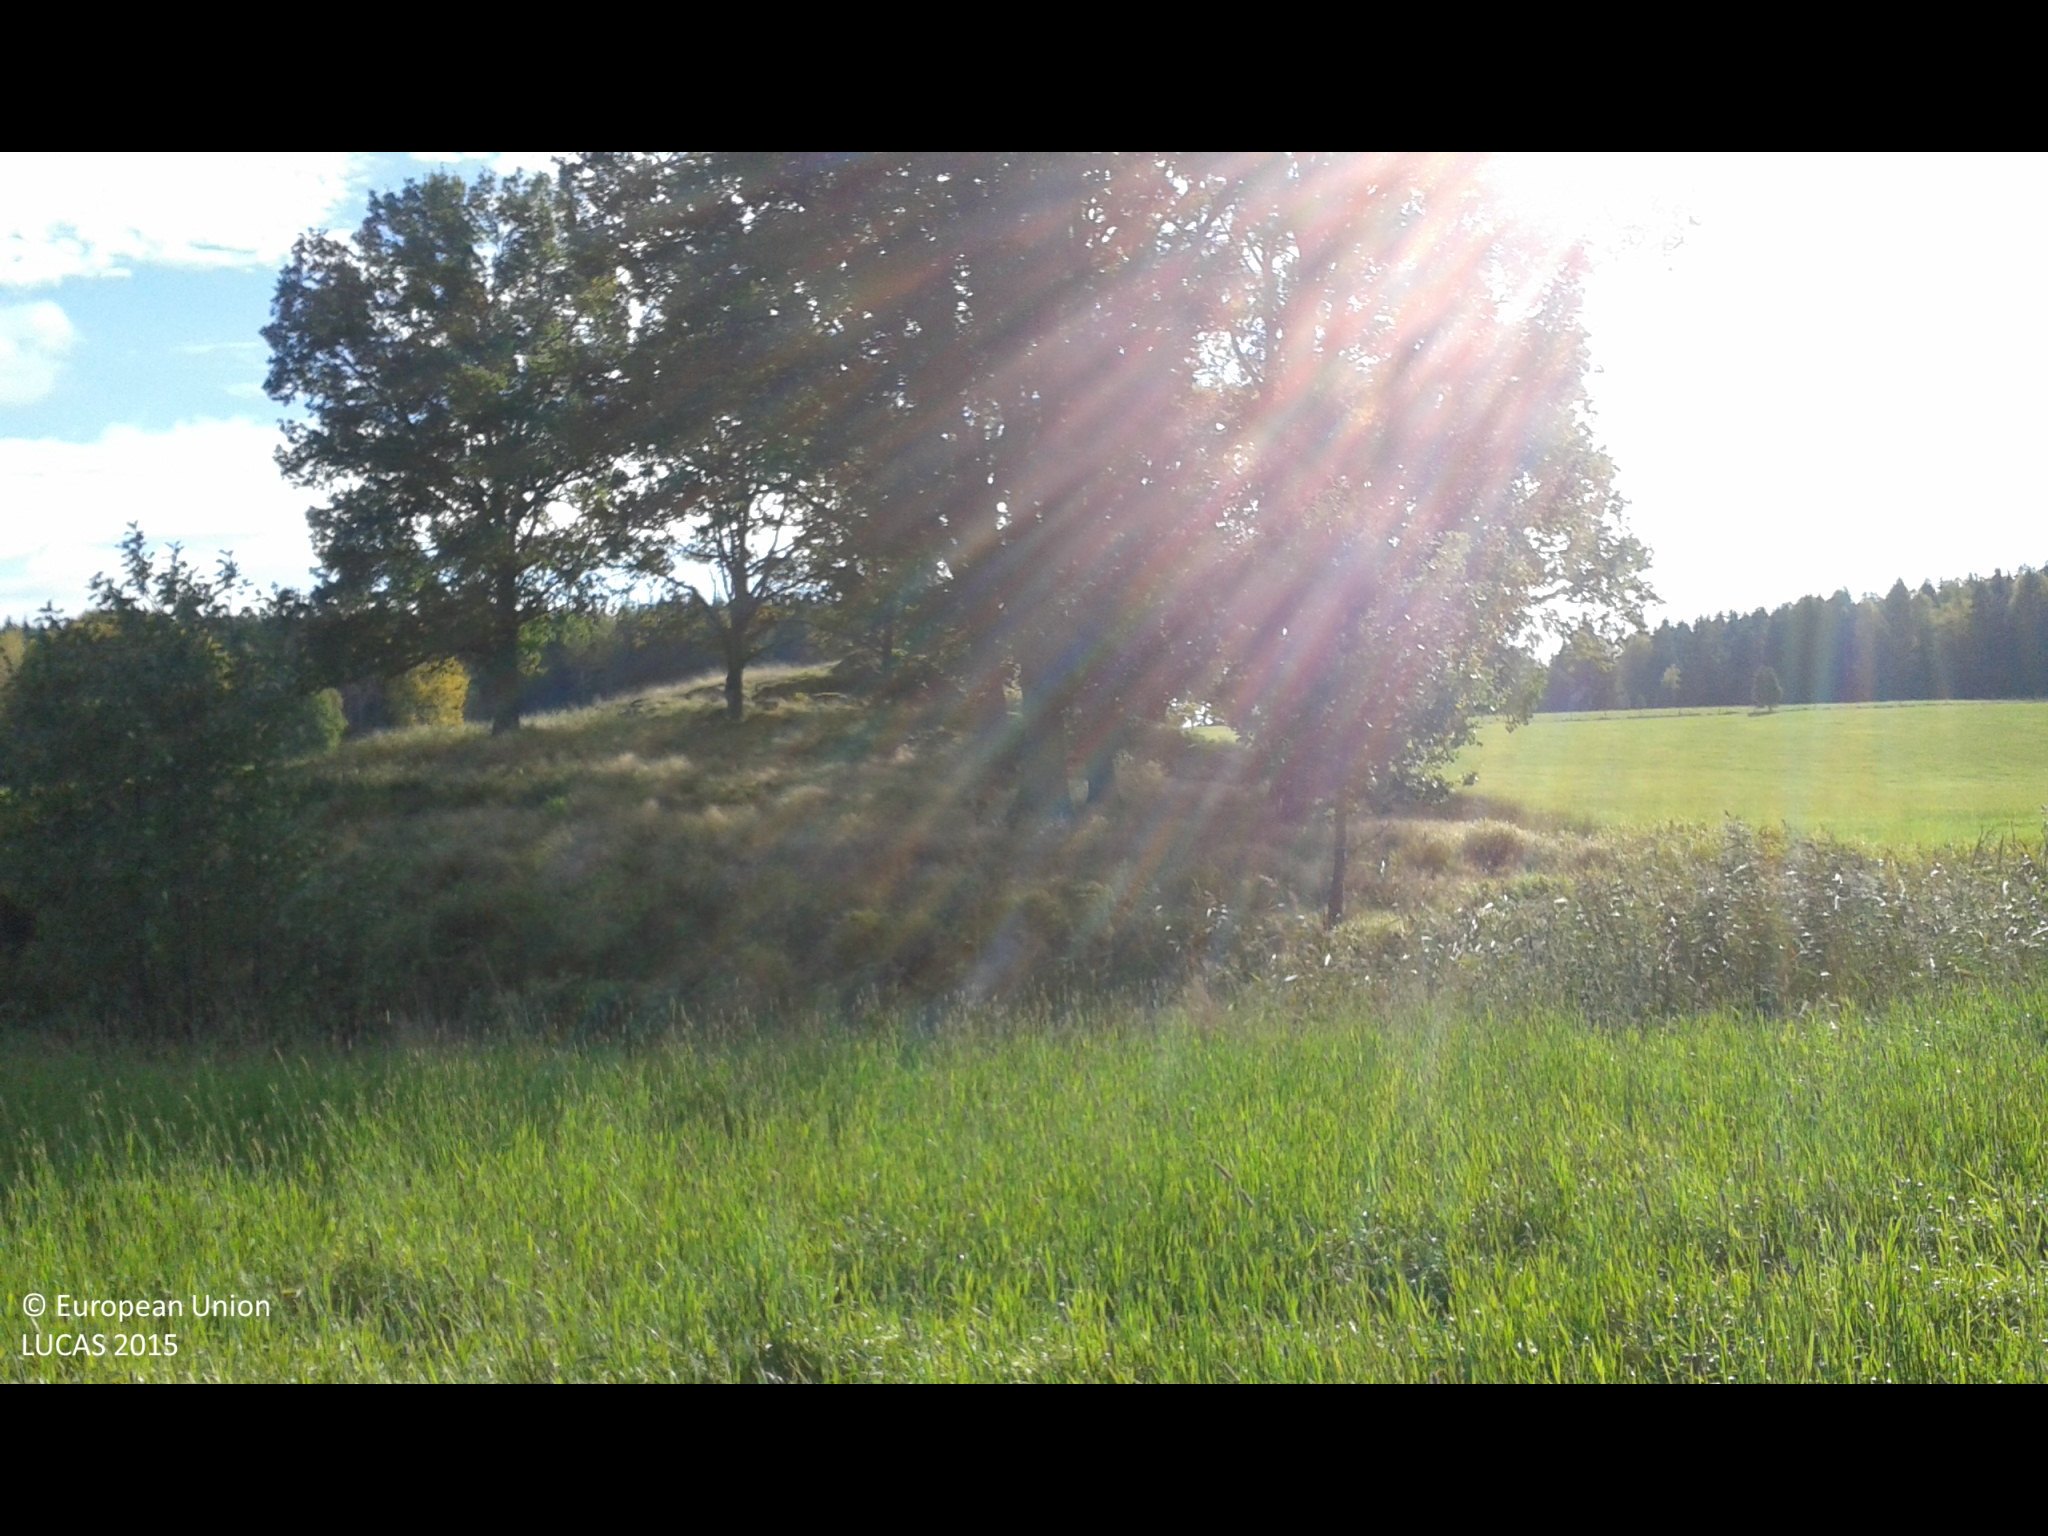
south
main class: Grassland
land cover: Grassland without tree/shrub cover
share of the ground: > 75 %
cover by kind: herbaceous plants 100 %
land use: Agriculture (excluding fallow land and kitchen gardens)
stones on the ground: < 10 %
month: October
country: SE
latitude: 58.9190
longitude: 17.0645
